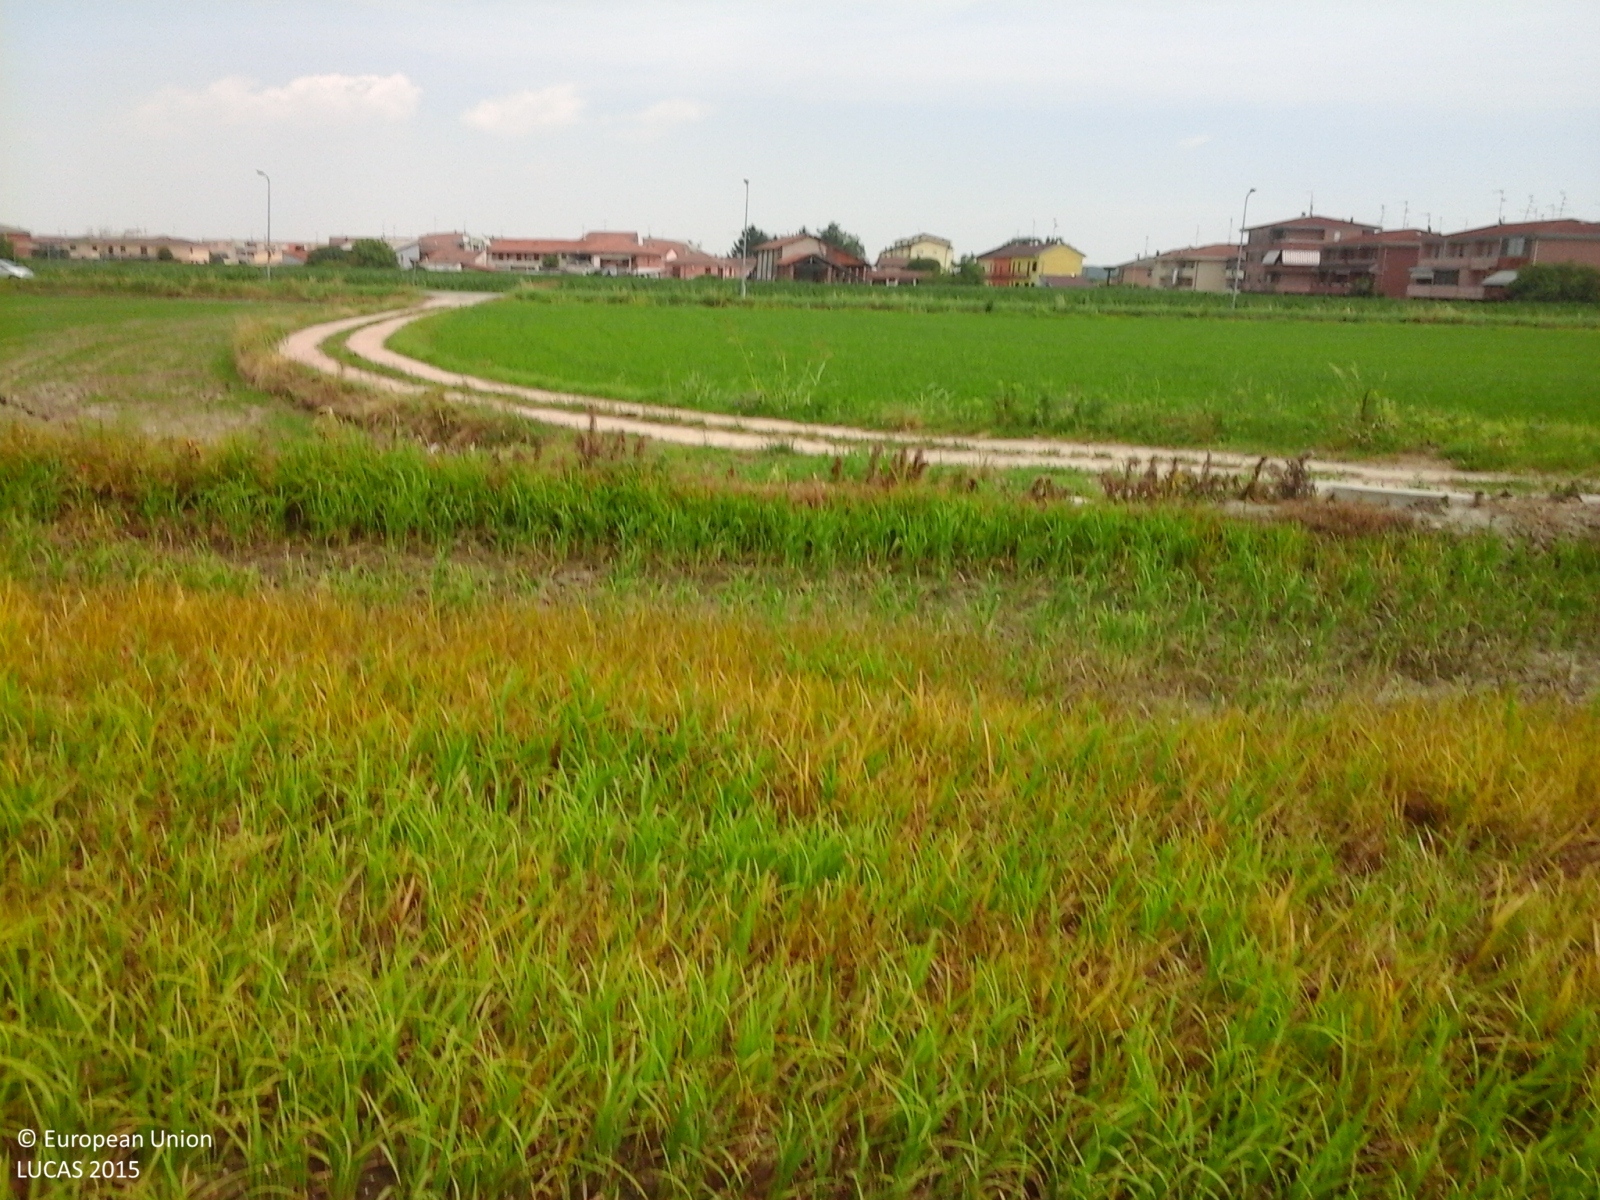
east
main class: Cropland
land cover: Rice
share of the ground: > 75 %
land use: Agriculture (excluding fallow land and kitchen gardens)
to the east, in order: Rice; Grass margins; Ditches and canals; Grass margins; Tracks; Grass margins; Rice; Grass margins; Ditches and canals; Grass margins; Paved roads, cycling and walking lanes; Grass margins; Ditches and canals; Maize; Grass margins; Tracks; Grass margins; Artificial constructions in urban areas
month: June
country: IT
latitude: 45.4048
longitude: 8.5843
